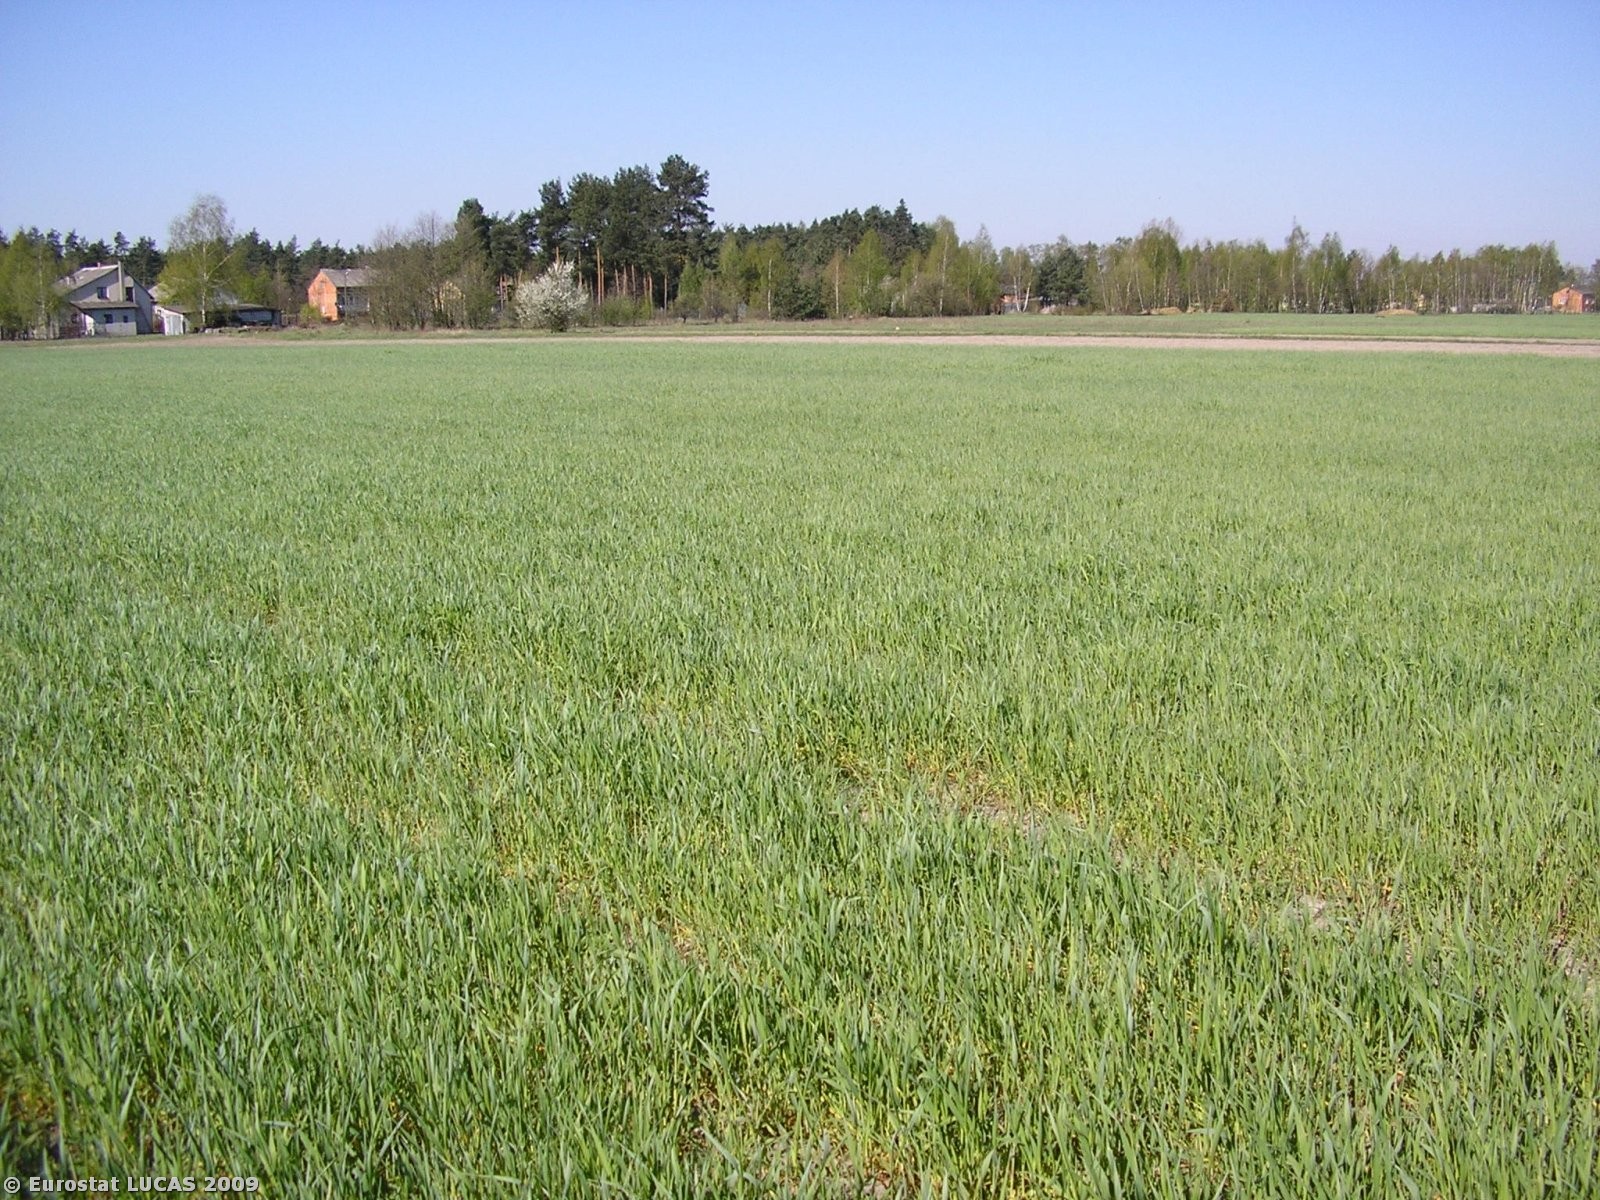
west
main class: Cropland
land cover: Rye
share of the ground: > 75 %
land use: Agriculture (excluding fallow land and kitchen gardens)
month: April
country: PL
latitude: 52.1220
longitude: 20.1561
